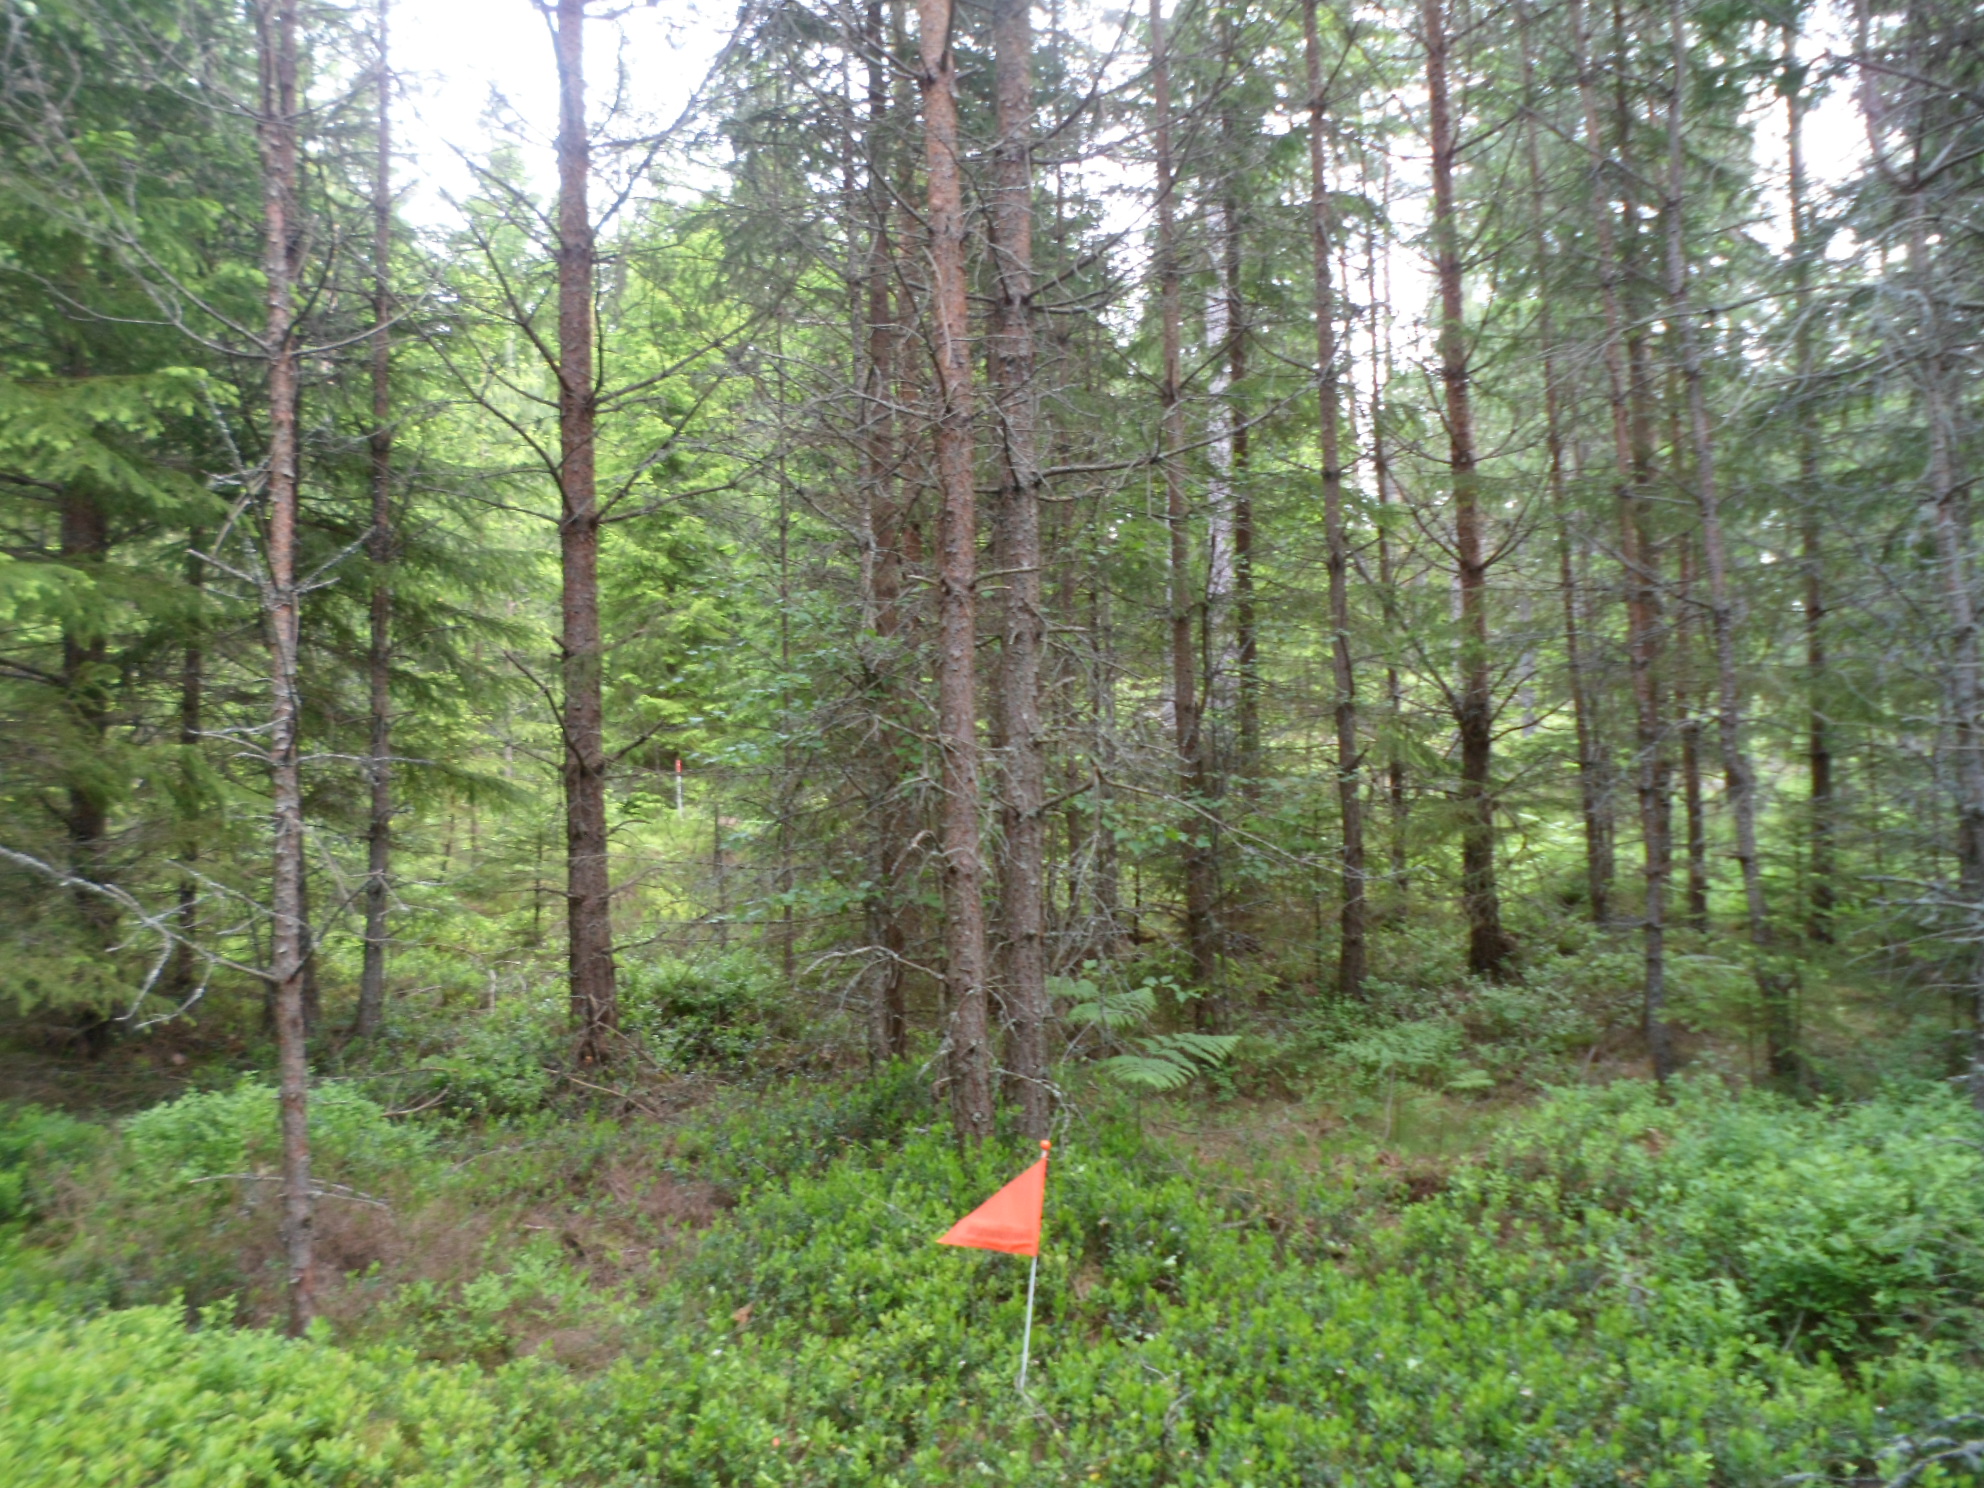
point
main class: Woodland
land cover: Pine dominated coniferous woodland
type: boreal forest
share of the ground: 50 - 75 %
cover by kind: coniferous forest trees 70 %, shrubs 15 %, lichens and mosses 10 %, herbaceous plants 5 %
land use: Forestry
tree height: > 5 m
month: June
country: SE
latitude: 57.0161
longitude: 15.2843
